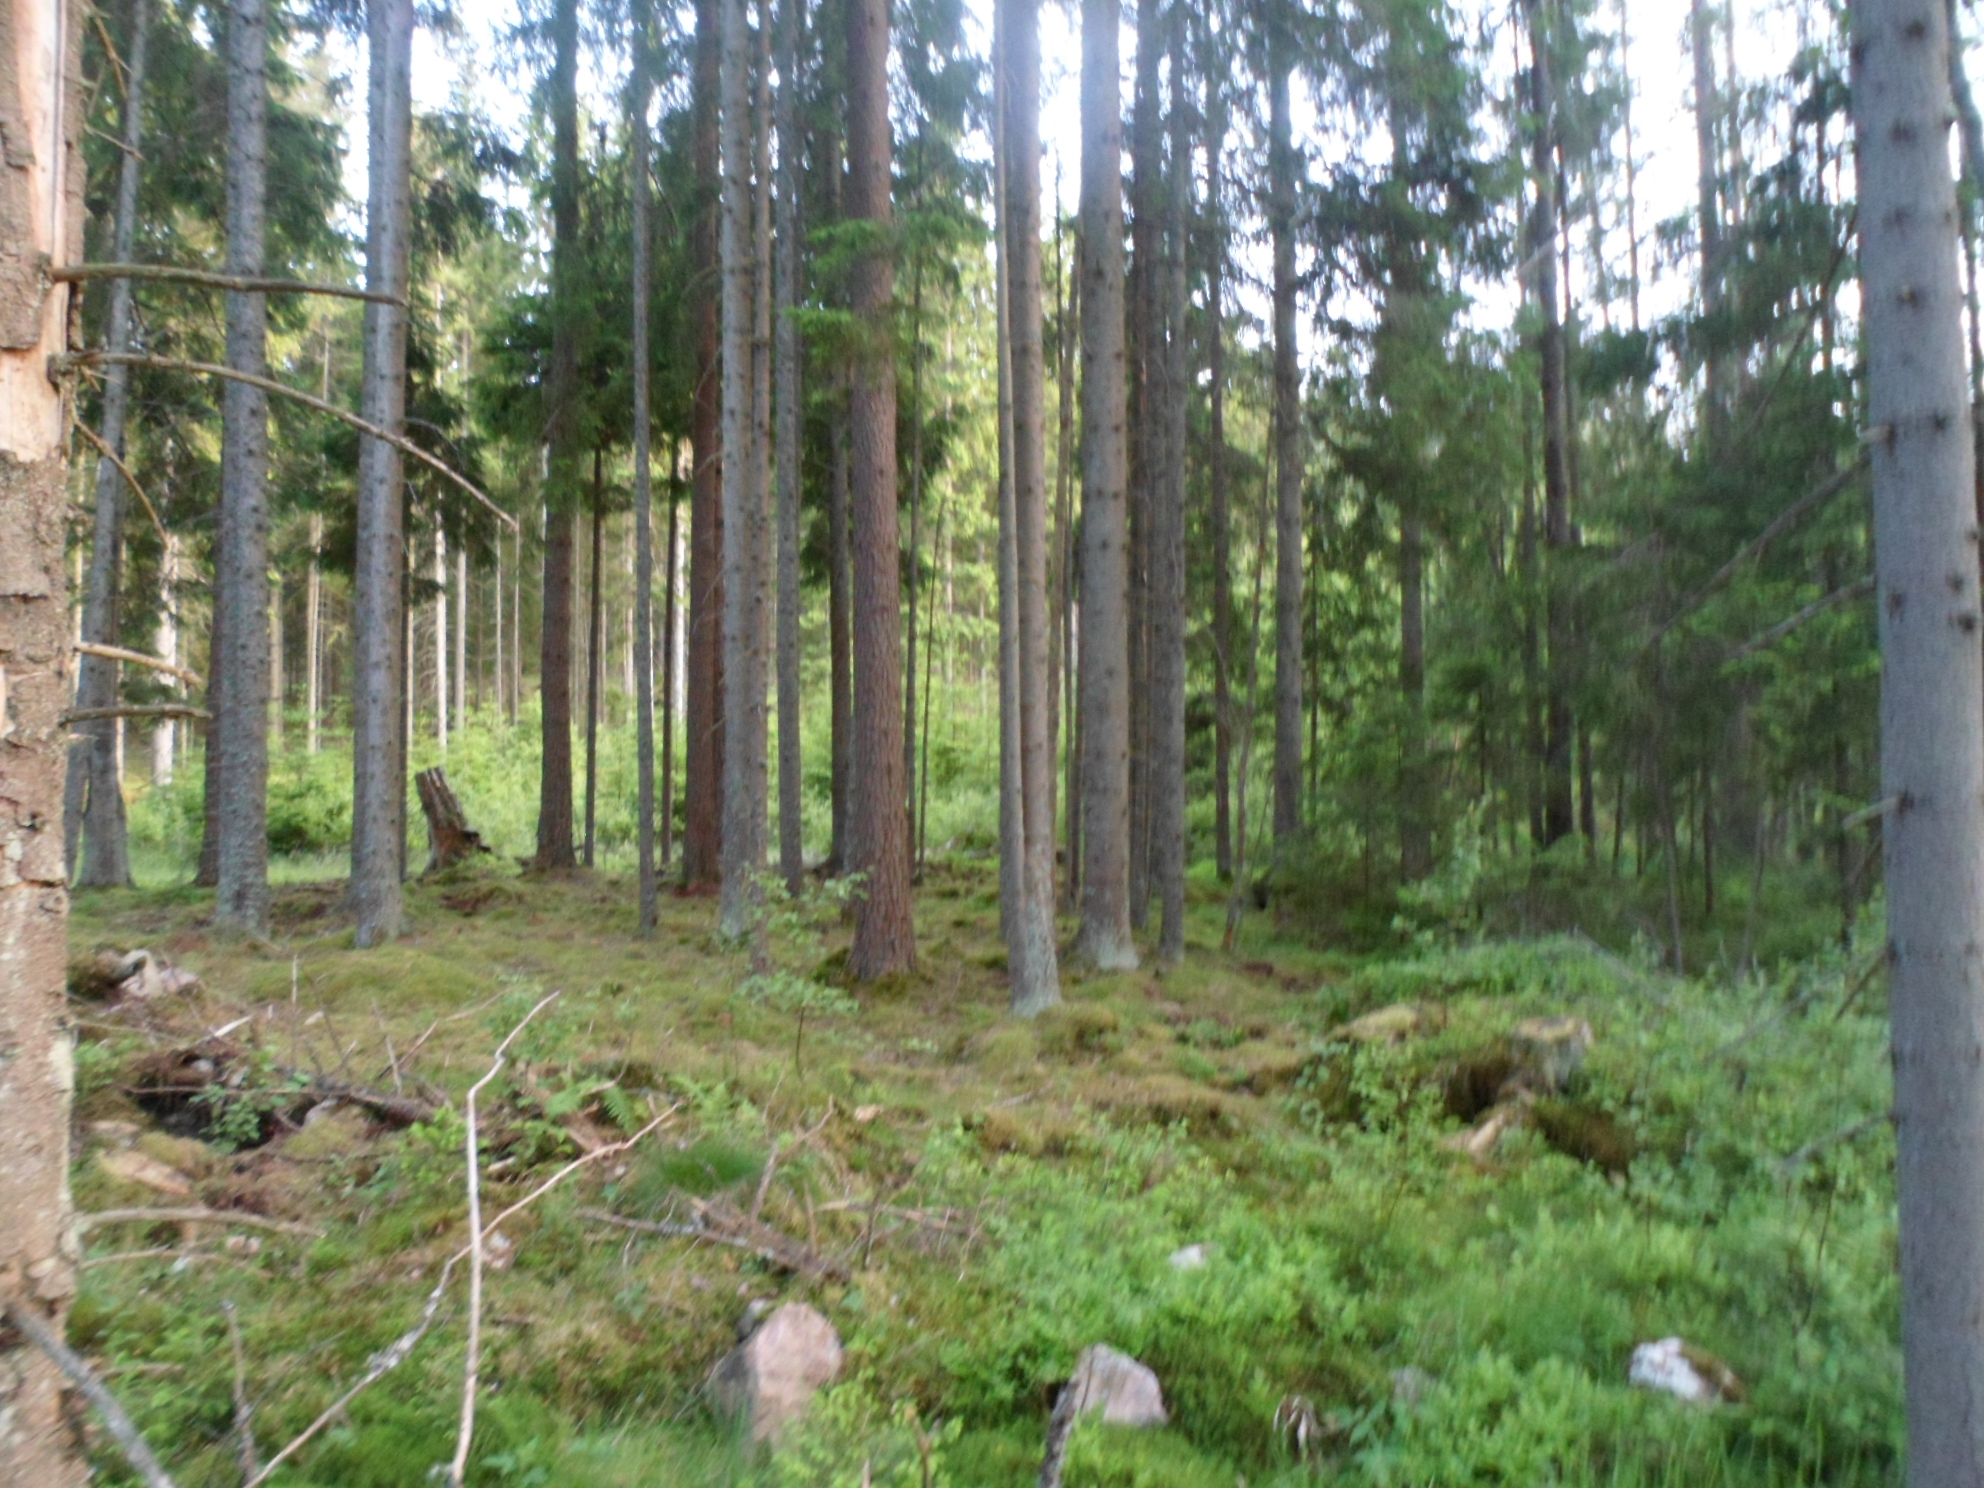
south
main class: Woodland
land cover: Spruce dominated coniferous woodland
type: boreal forest
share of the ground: 50 - 75 %
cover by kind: coniferous forest trees 55 %, shrubs 15 %, lichens and mosses 15 %, broadleaved forest trees 10 %, herbaceous plants 5 %
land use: Forestry
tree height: > 5 m
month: June
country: SE
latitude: 57.0479
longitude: 15.3879
